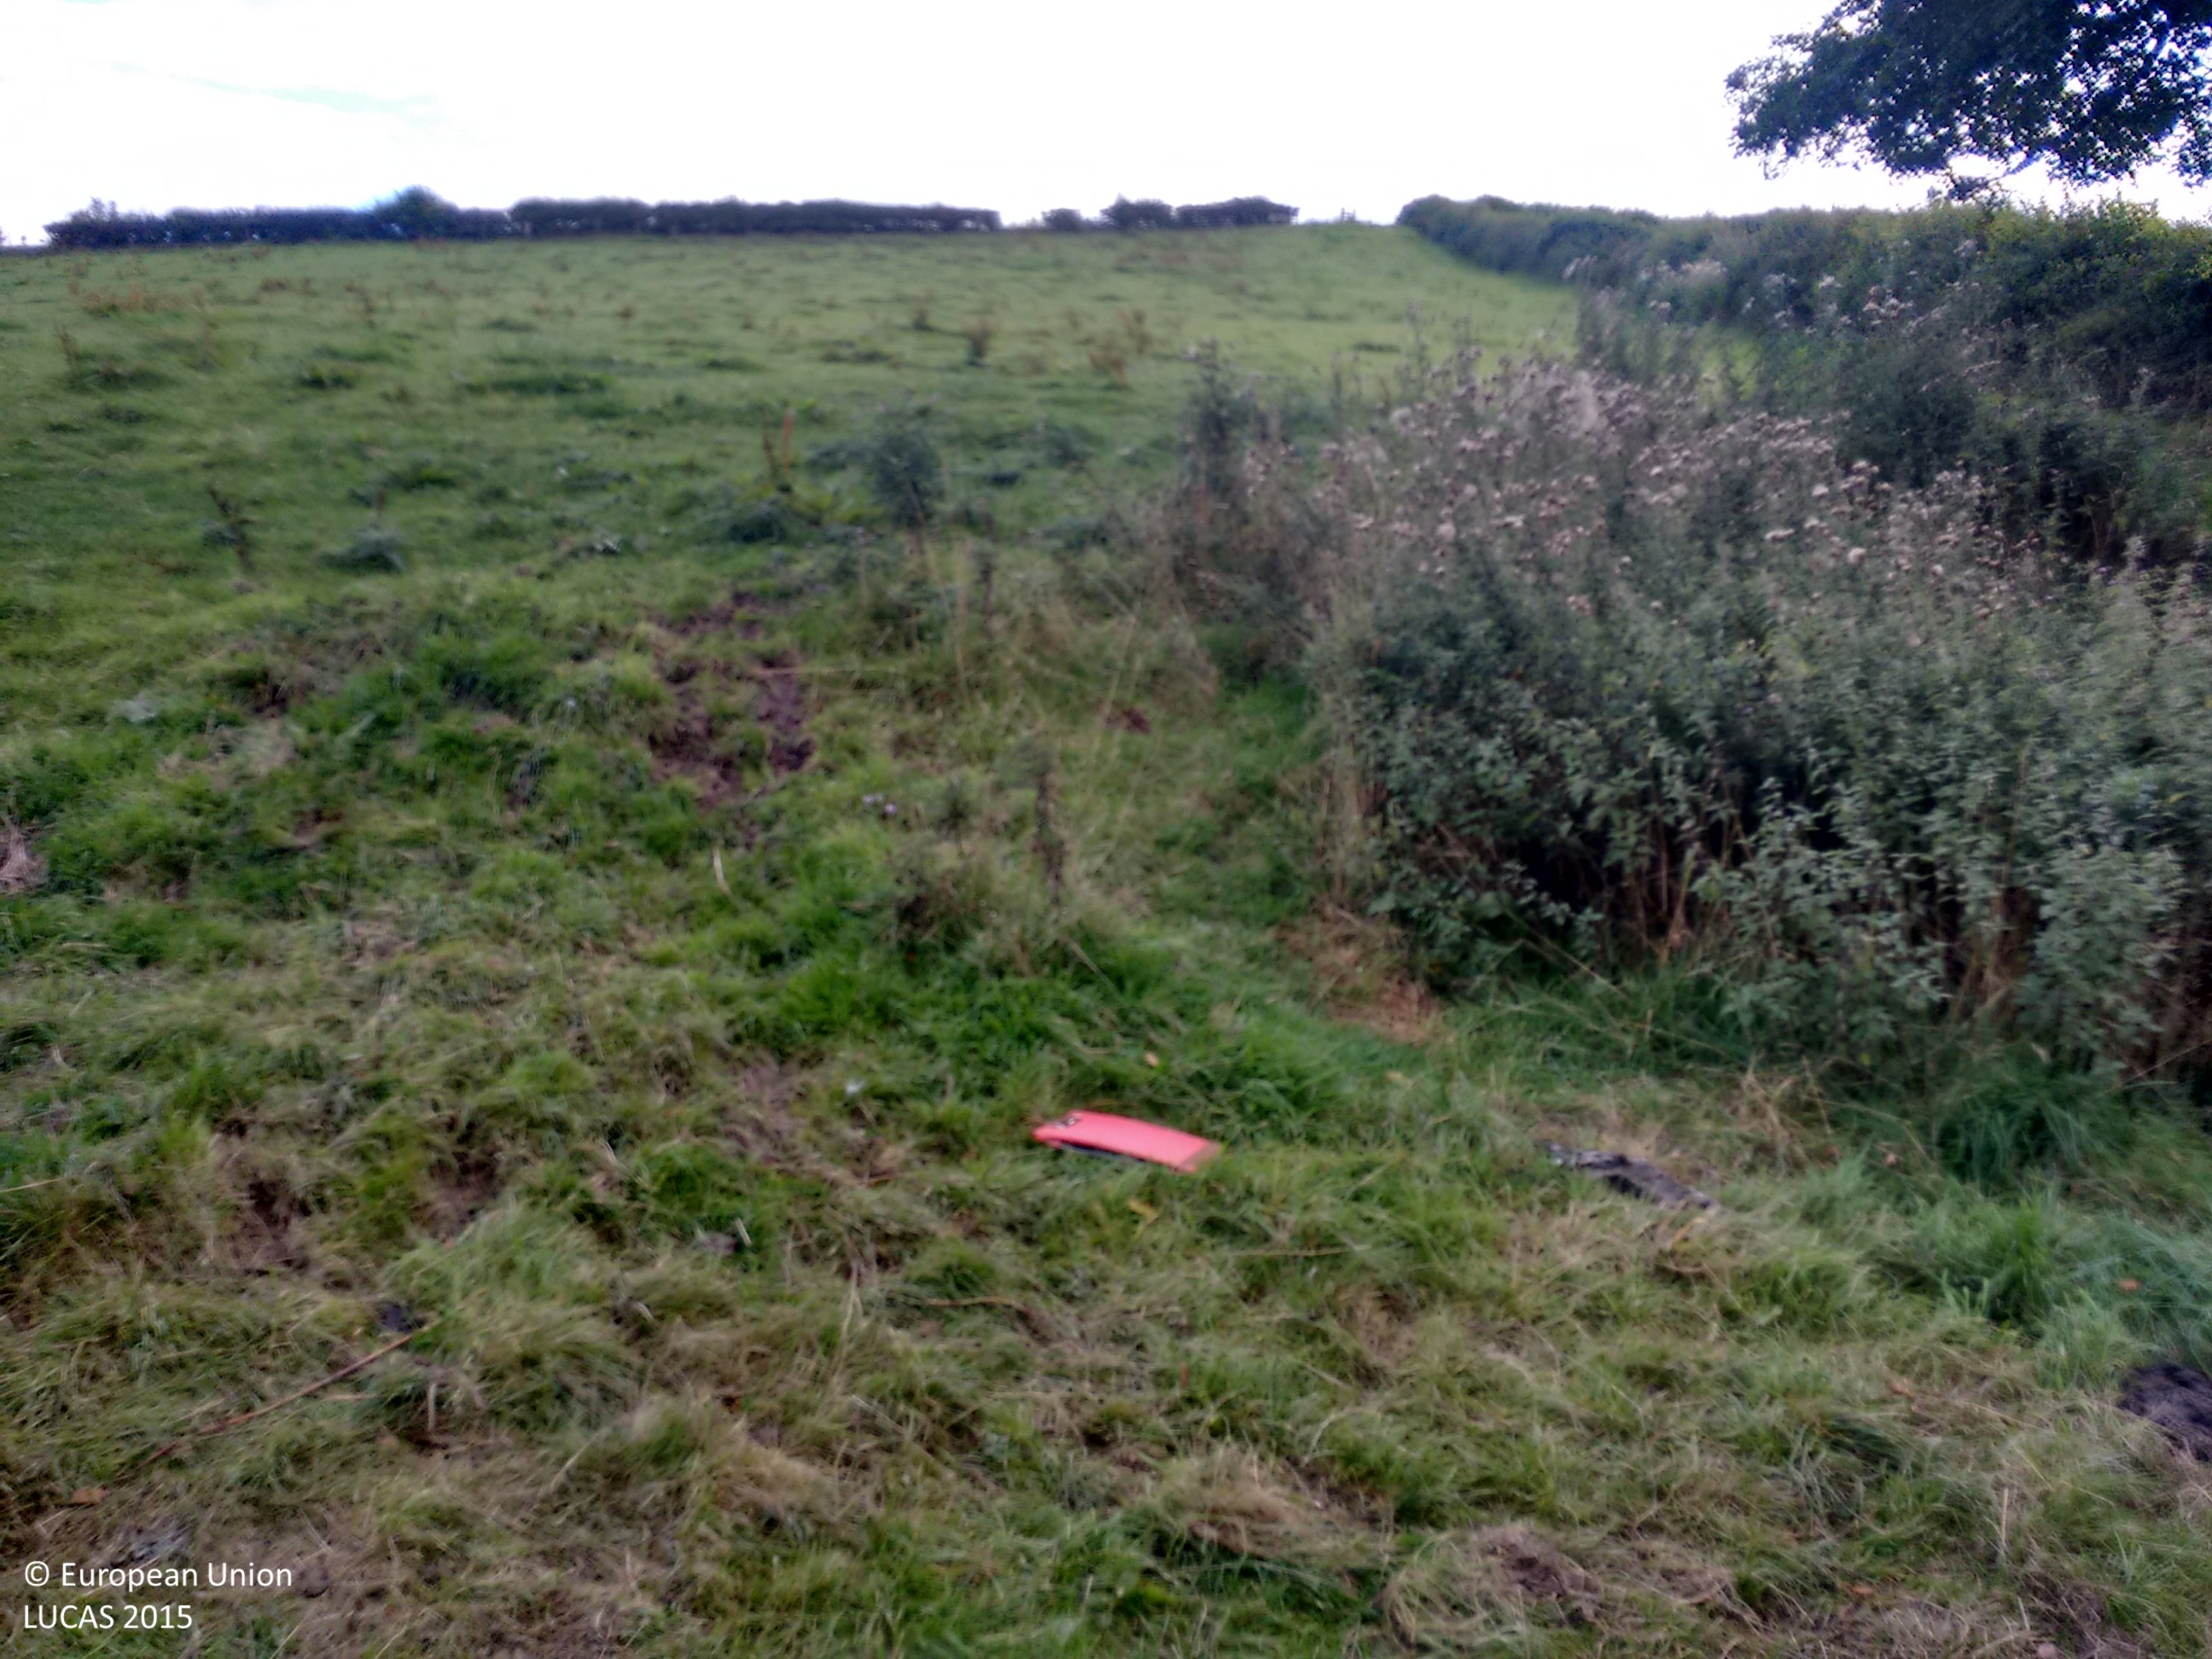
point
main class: Grassland
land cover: Grassland without tree/shrub cover
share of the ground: > 75 %
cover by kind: herbaceous plants 100 %
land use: Agriculture (excluding fallow land and kitchen gardens)
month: September
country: GB
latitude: 52.6448
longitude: -3.3082
